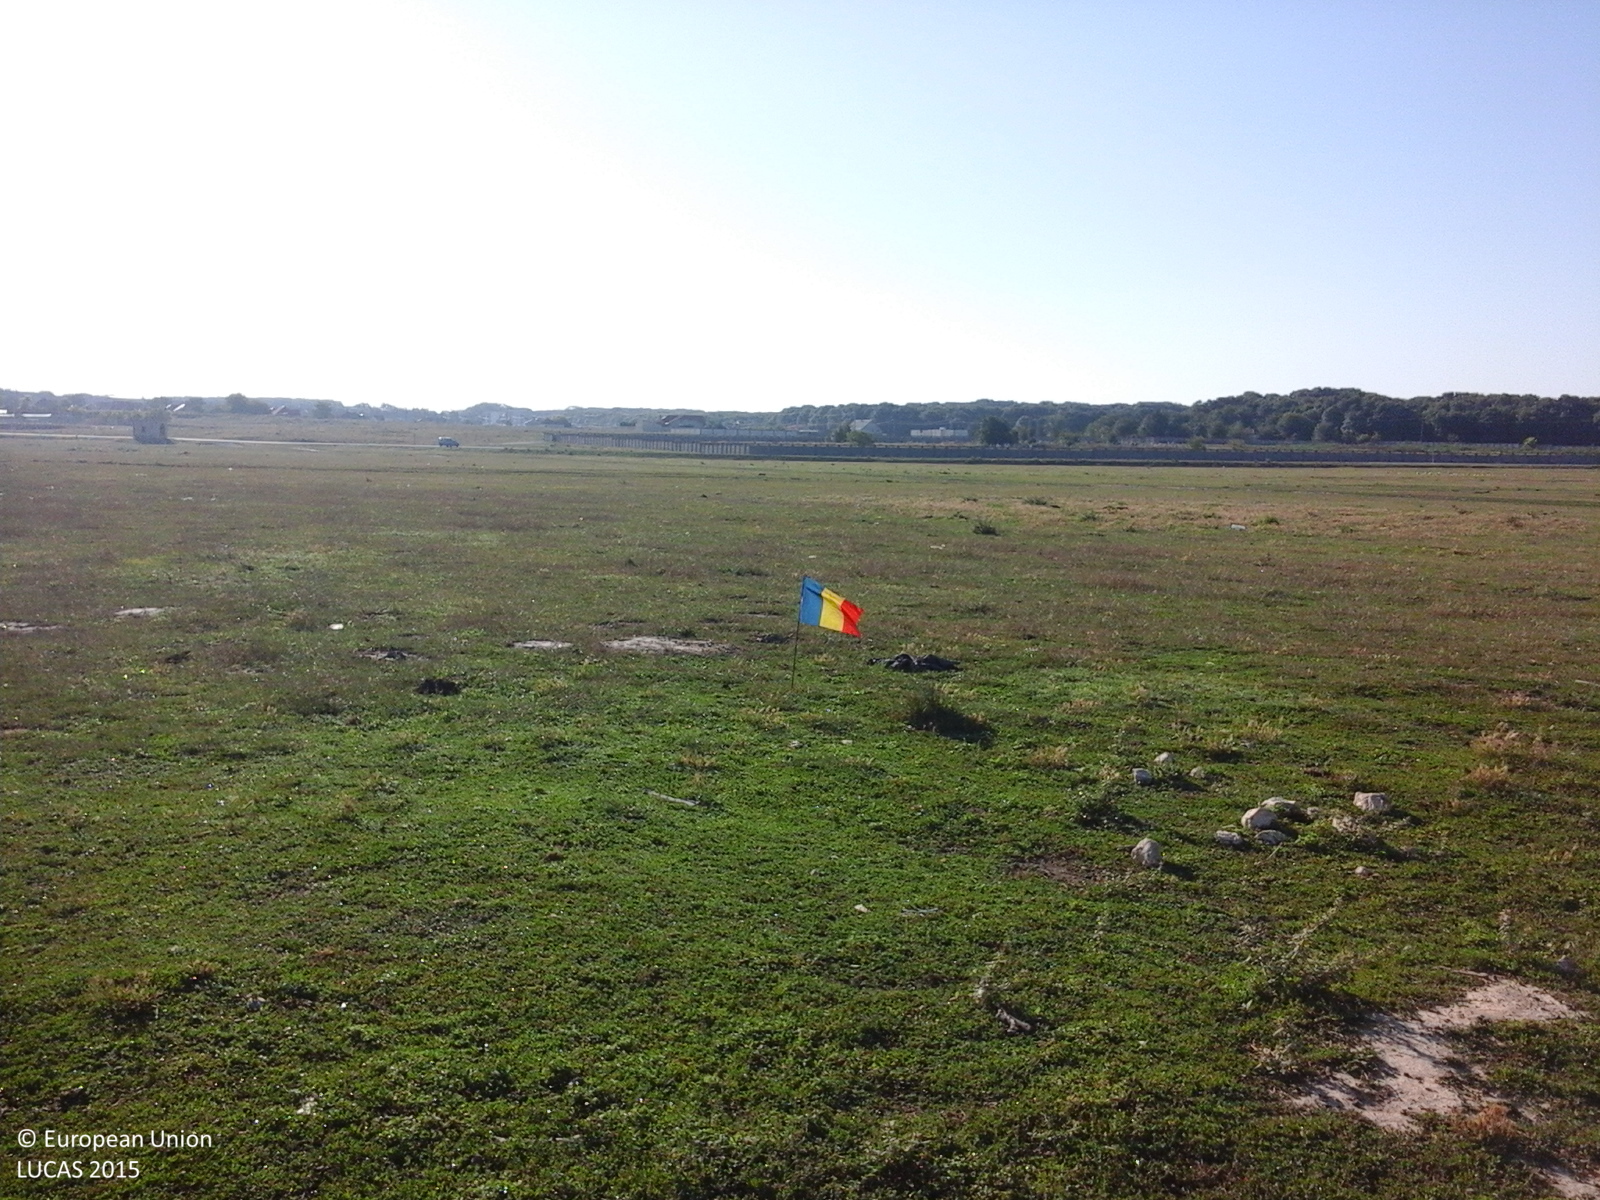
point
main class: Grassland
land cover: Grassland without tree/shrub cover
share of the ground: > 75 %
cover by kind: herbaceous plants 100 %
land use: Agriculture (excluding fallow land and kitchen gardens)
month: August
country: RO
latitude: 44.3585
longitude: 28.4509
